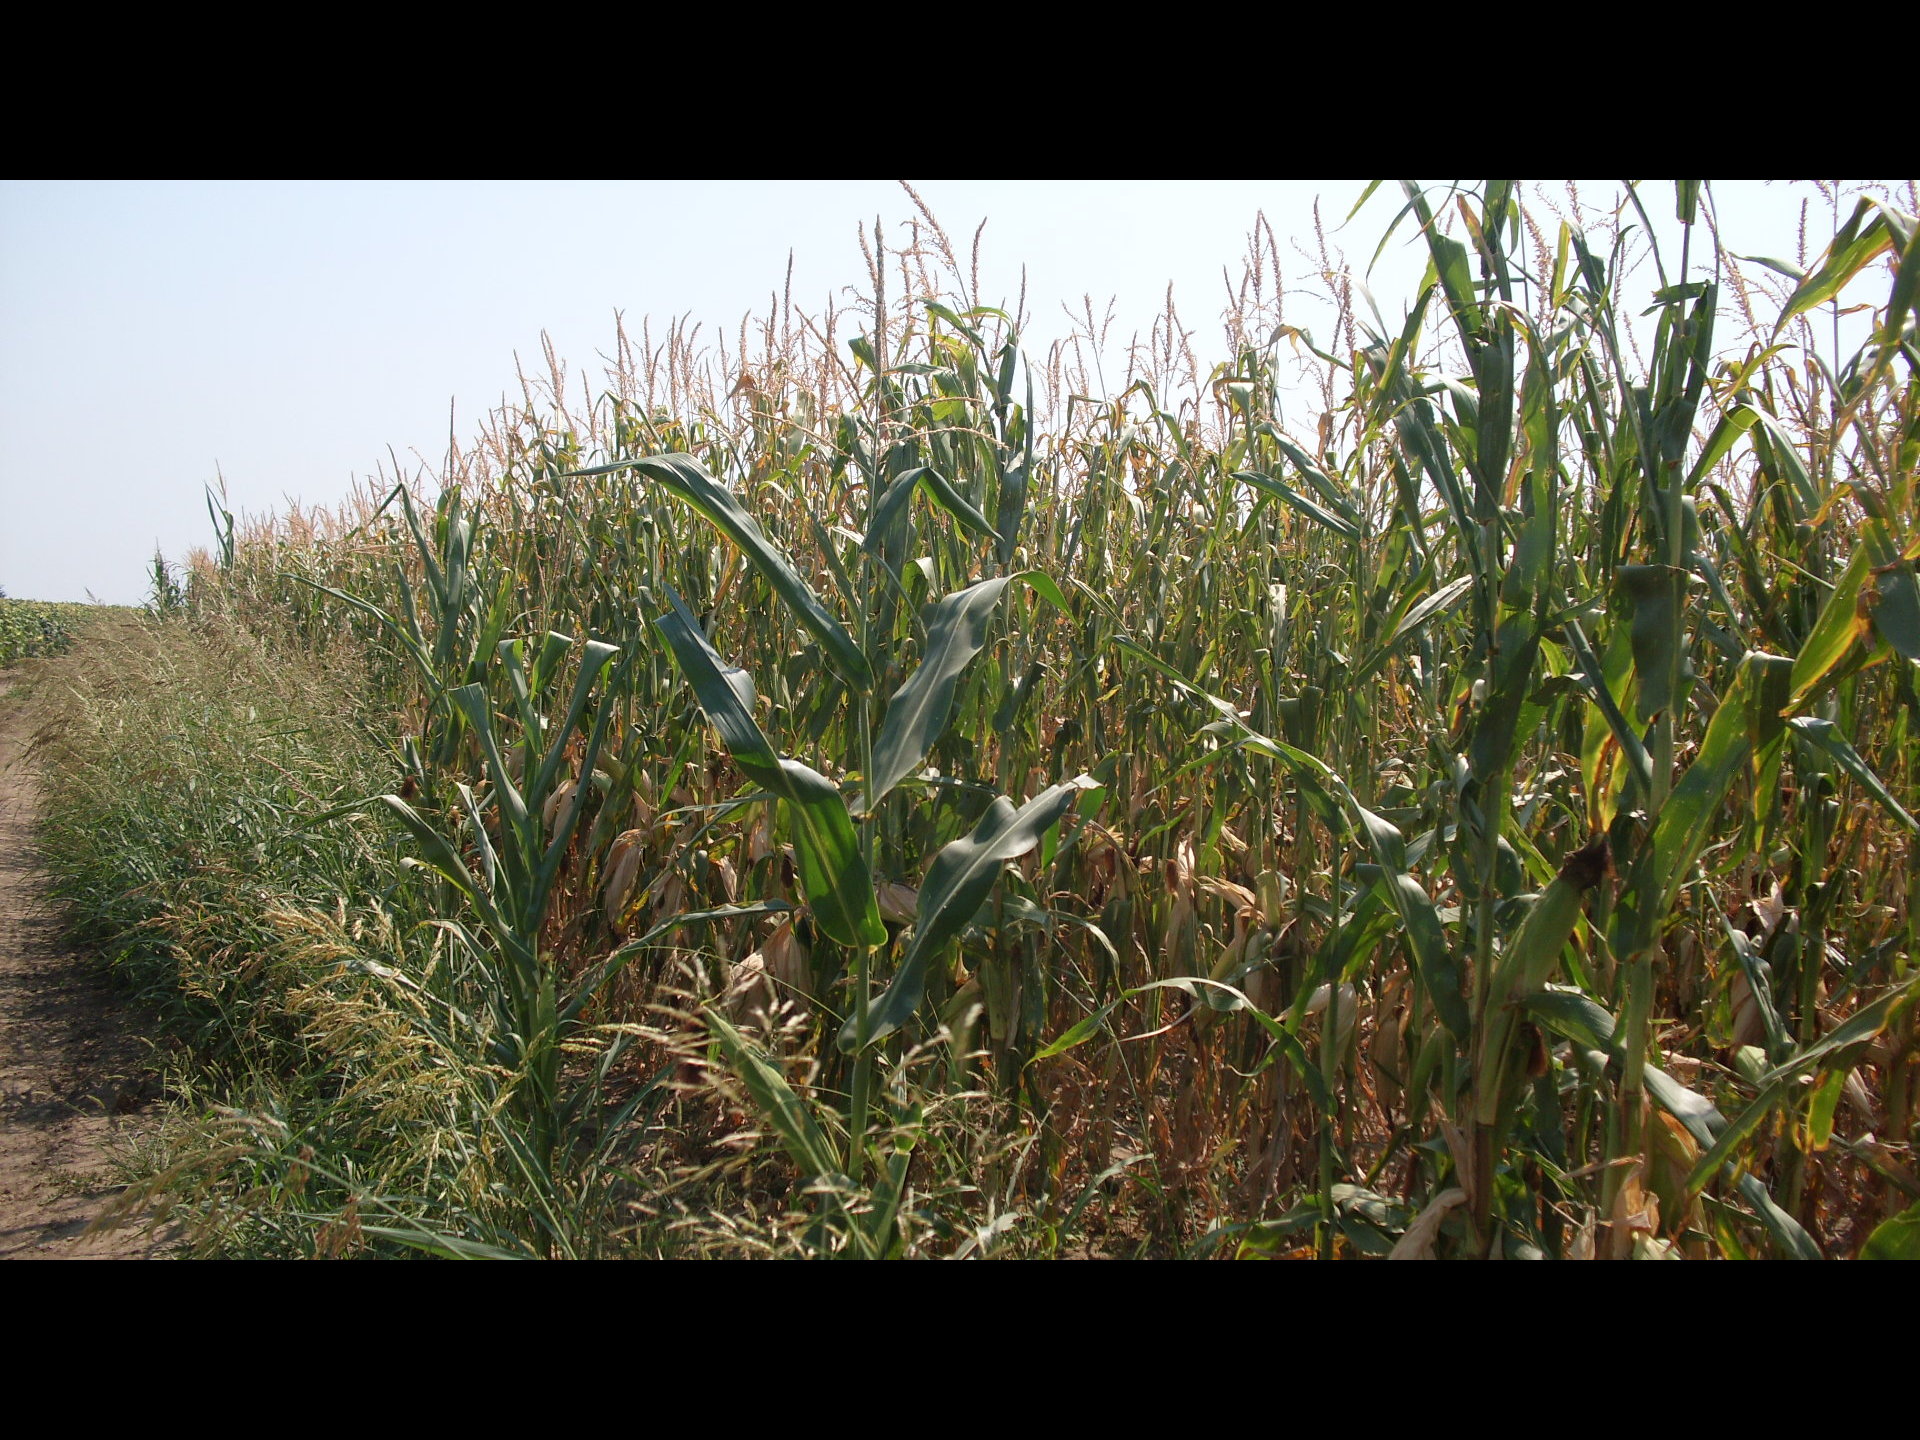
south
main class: Cropland
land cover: Maize
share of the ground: > 75 %
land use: Agriculture (excluding fallow land and kitchen gardens)
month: July
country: BG
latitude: 43.7901
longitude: 23.3797
